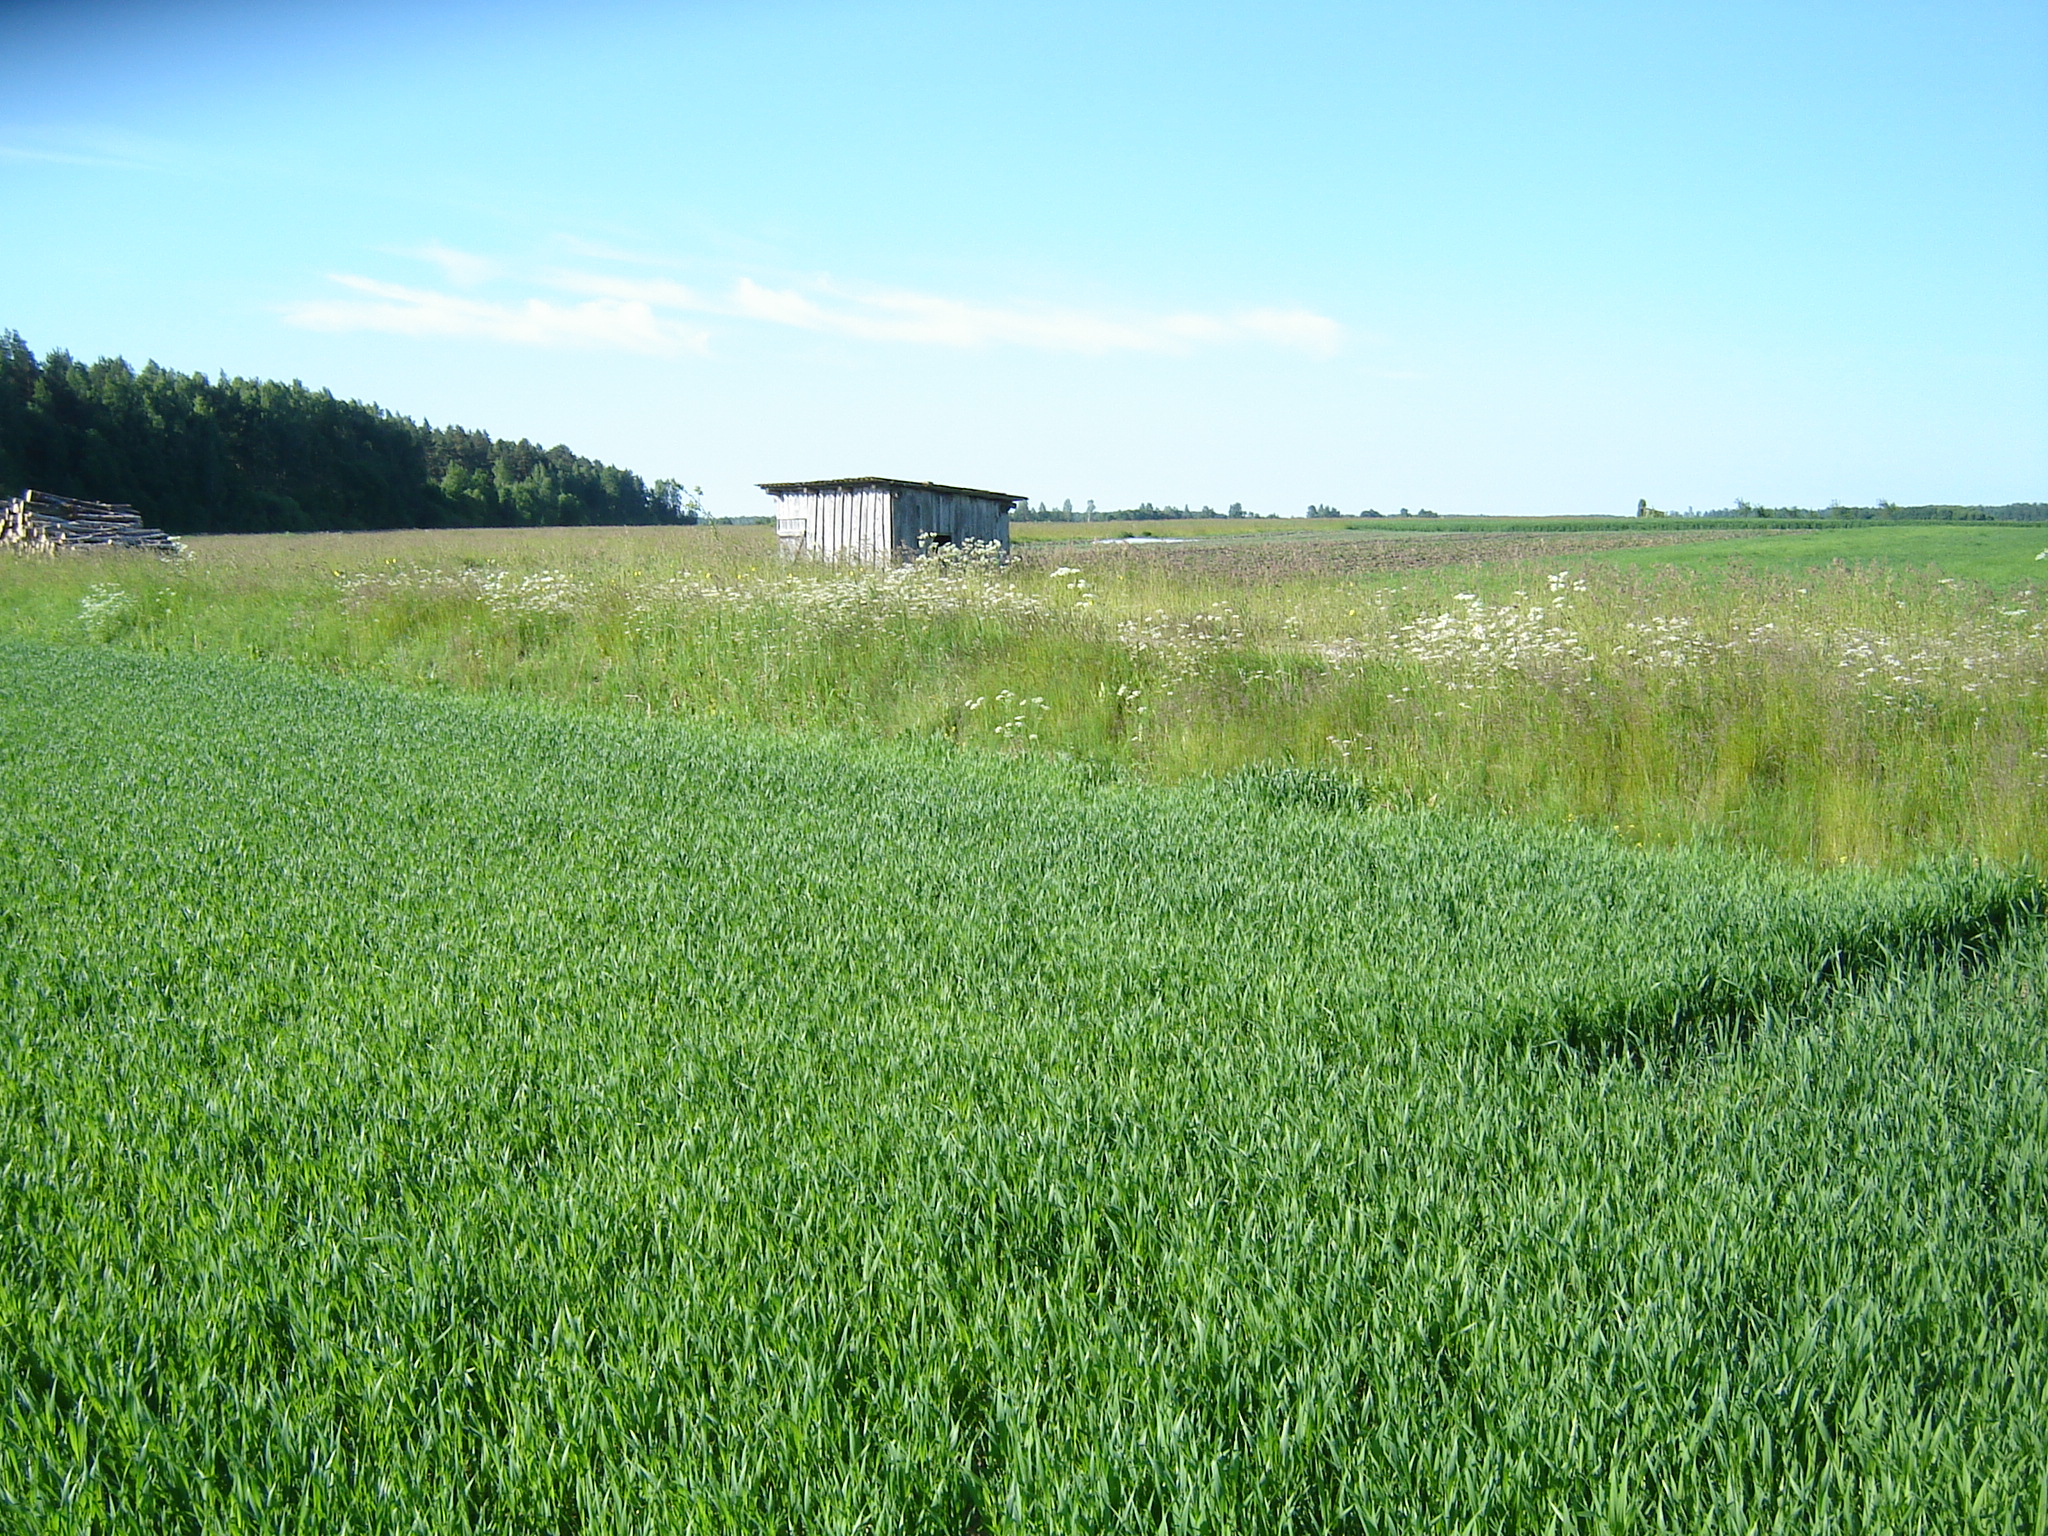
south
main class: Cropland
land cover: Common wheat
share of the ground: > 75 %
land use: Agriculture (excluding fallow land and kitchen gardens)
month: June
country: LT
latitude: 55.5252
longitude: 24.7912
